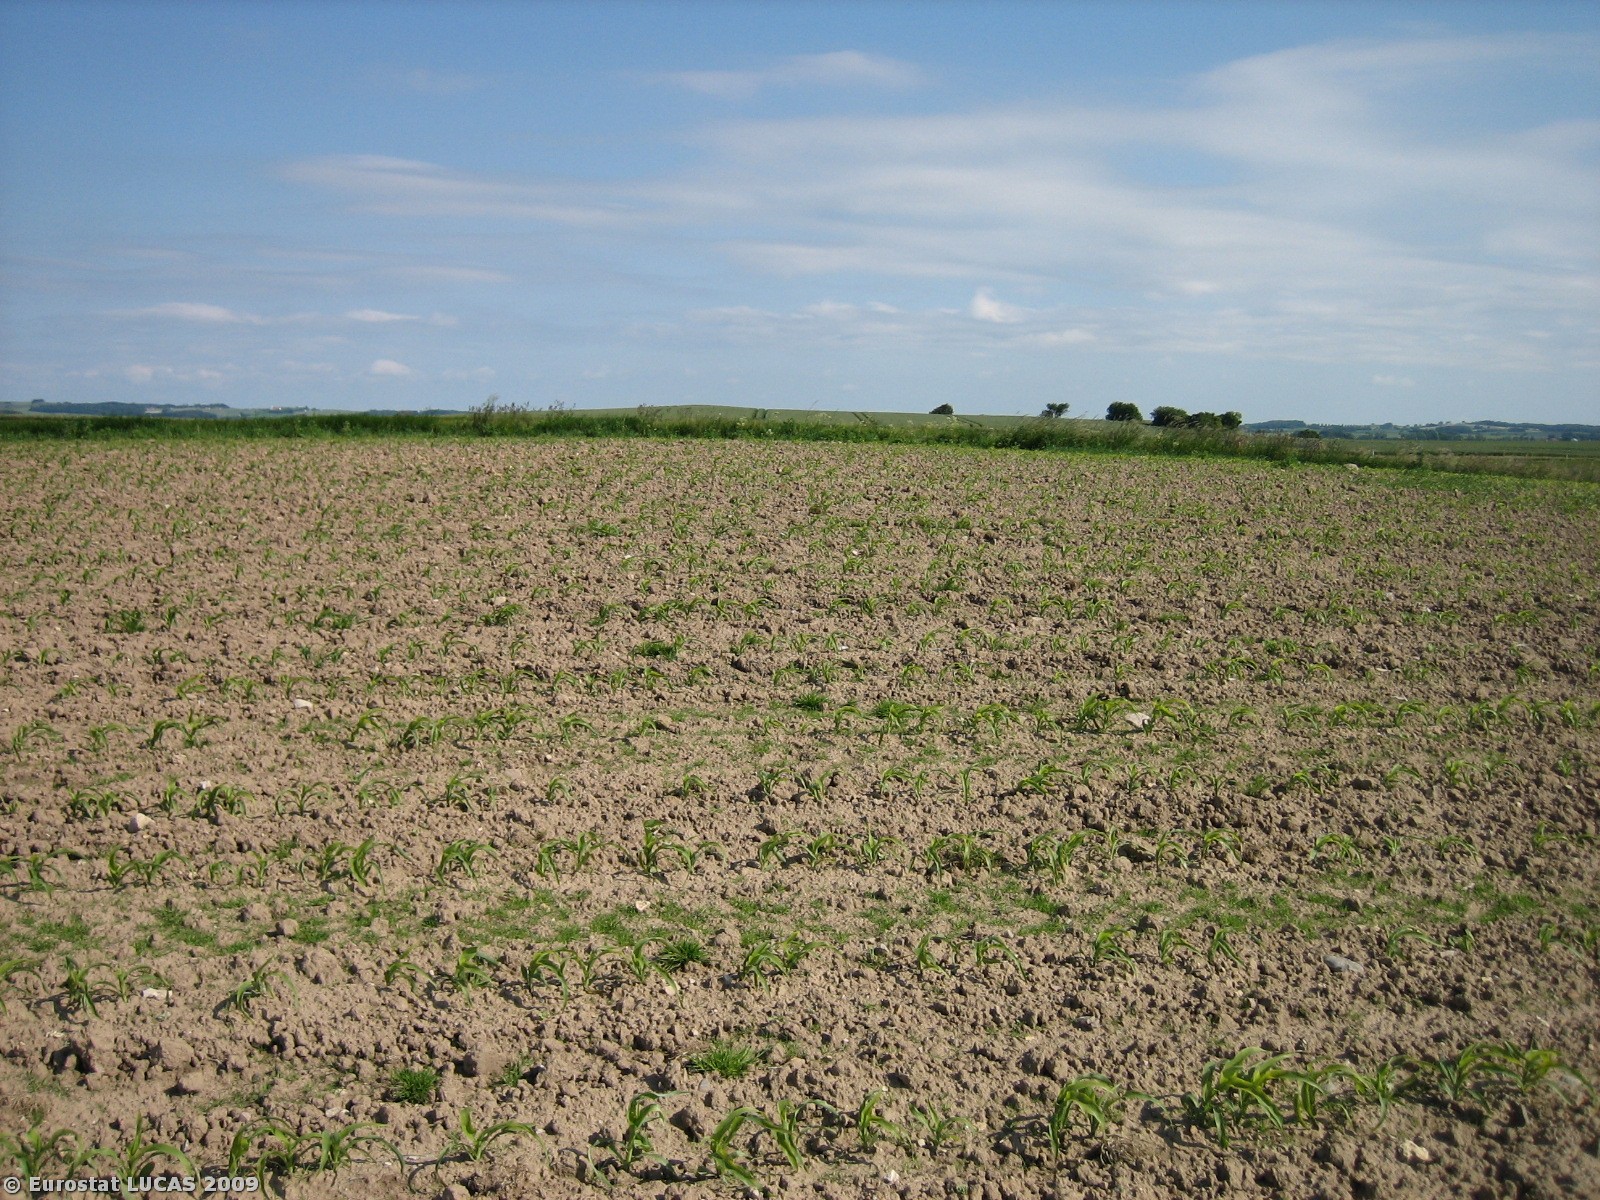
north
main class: Cropland
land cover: Maize
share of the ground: < 10 %
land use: Agriculture (excluding fallow land and kitchen gardens)
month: June
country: DK
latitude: 55.9181
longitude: 9.8881
